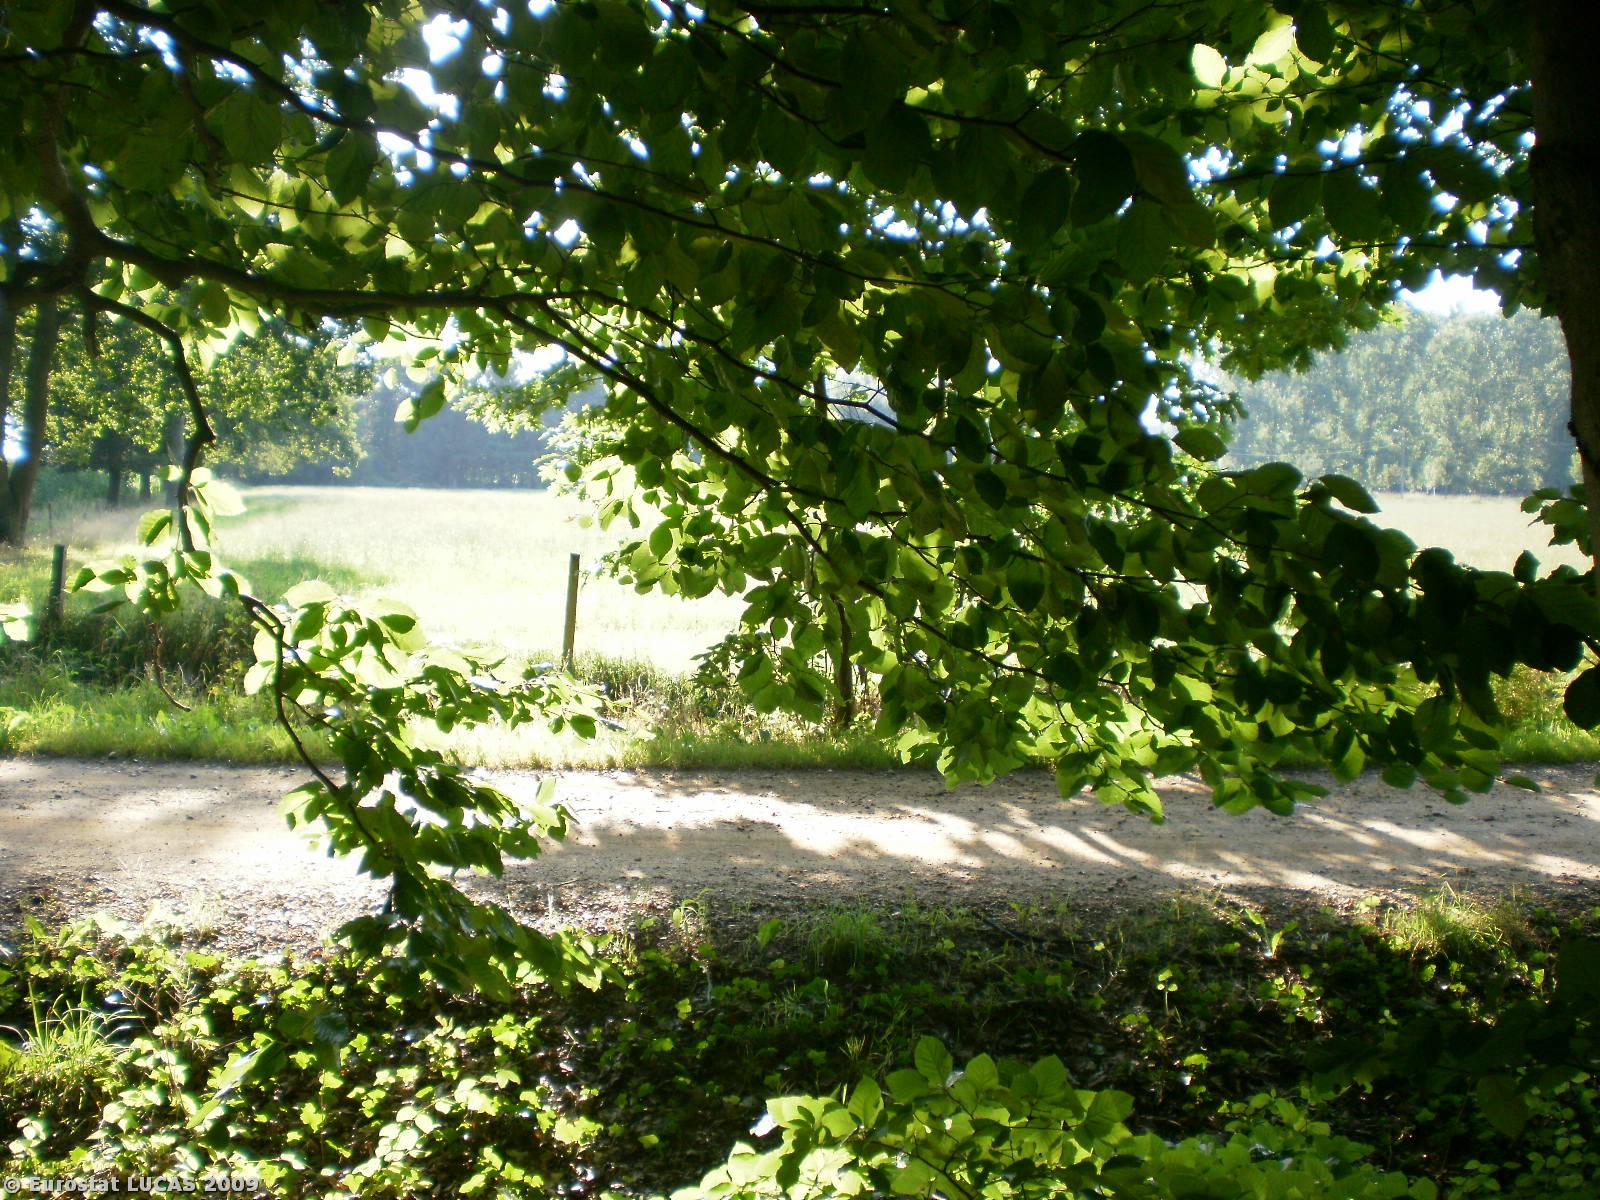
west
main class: Woodland
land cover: Broadleaved woodland
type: acidophilous oak and oak-birch forest
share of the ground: > 75 %
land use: Amenities, museums, leisure
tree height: > 5 m
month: June
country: BE
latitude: 50.8897
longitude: 5.5486
